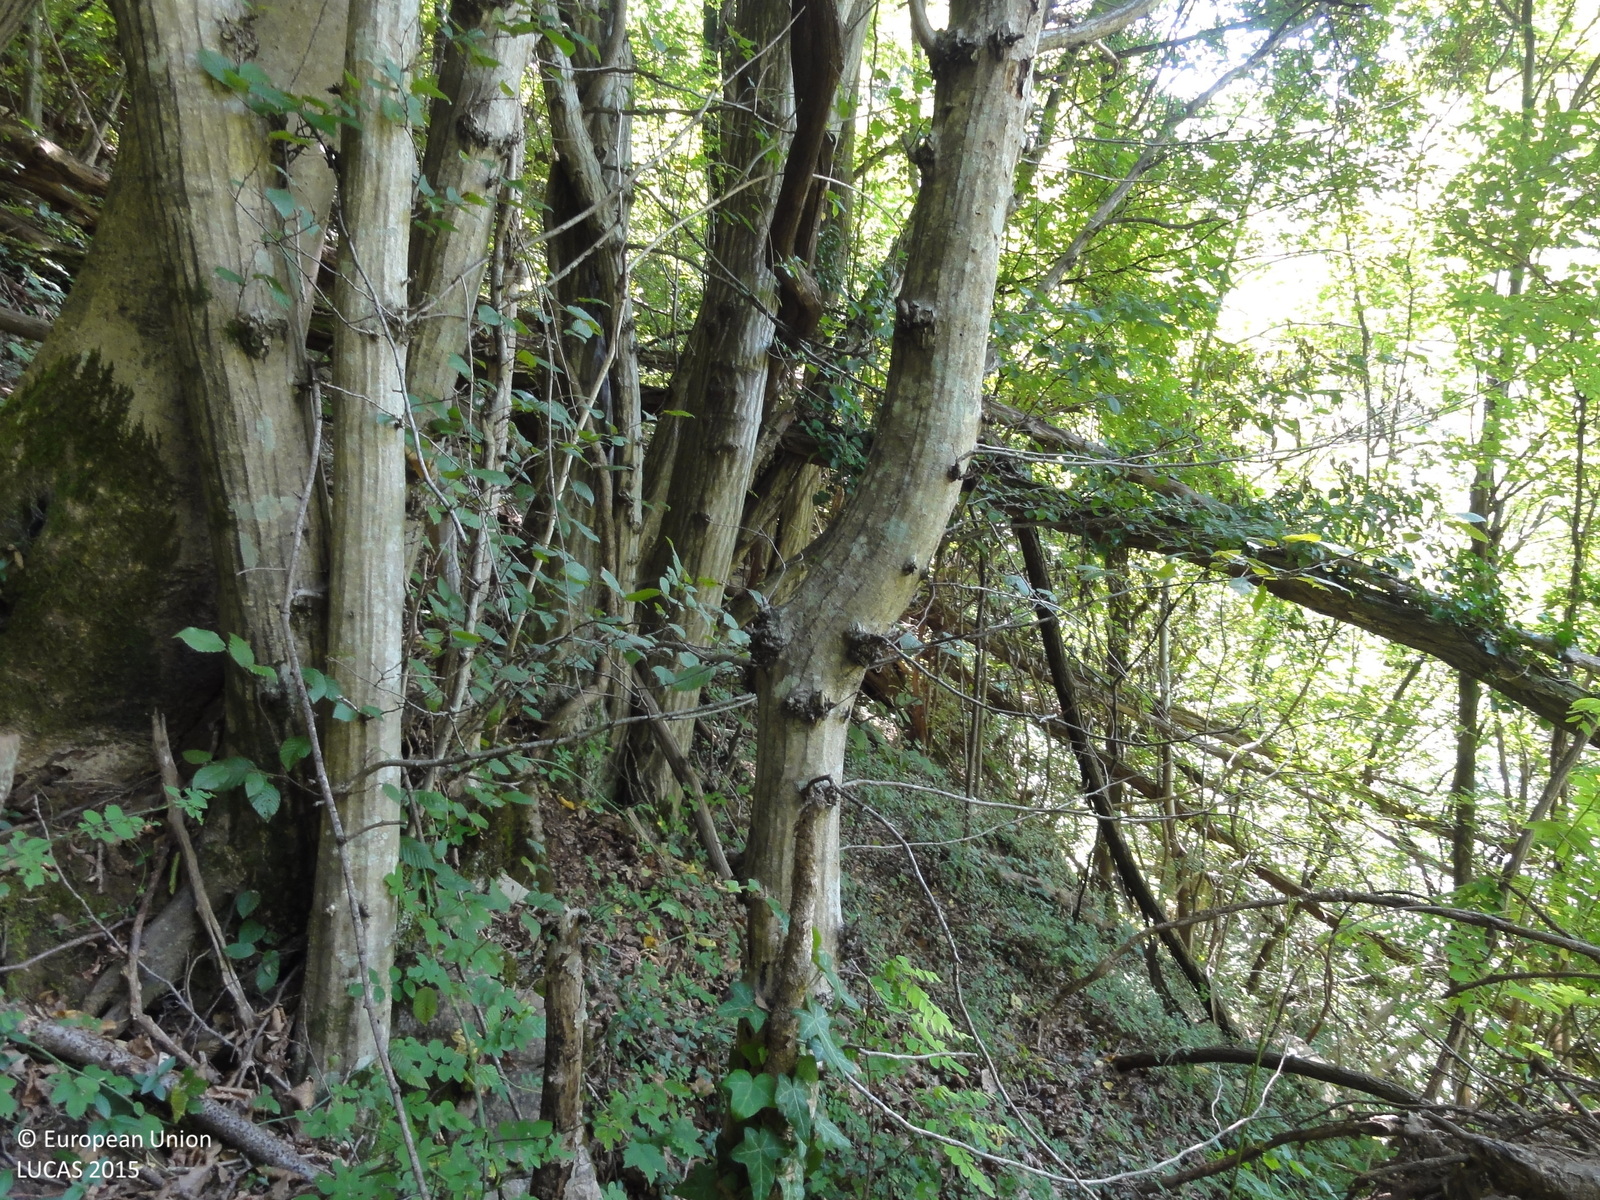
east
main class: Woodland
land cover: Broadleaved woodland
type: mesophytic deciduous forest
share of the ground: > 75 %
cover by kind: broadleaved forest trees 100 %
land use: Semi-natural and natural areas not in use
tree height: > 5 m
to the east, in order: Broadleaved woodland; Grassland without tree/shrub cover; Fences; Managed hedges; Other fruit trees and berries; Grassland without tree/shrub cover
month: August
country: SI
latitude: 46.1101
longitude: 13.6061
